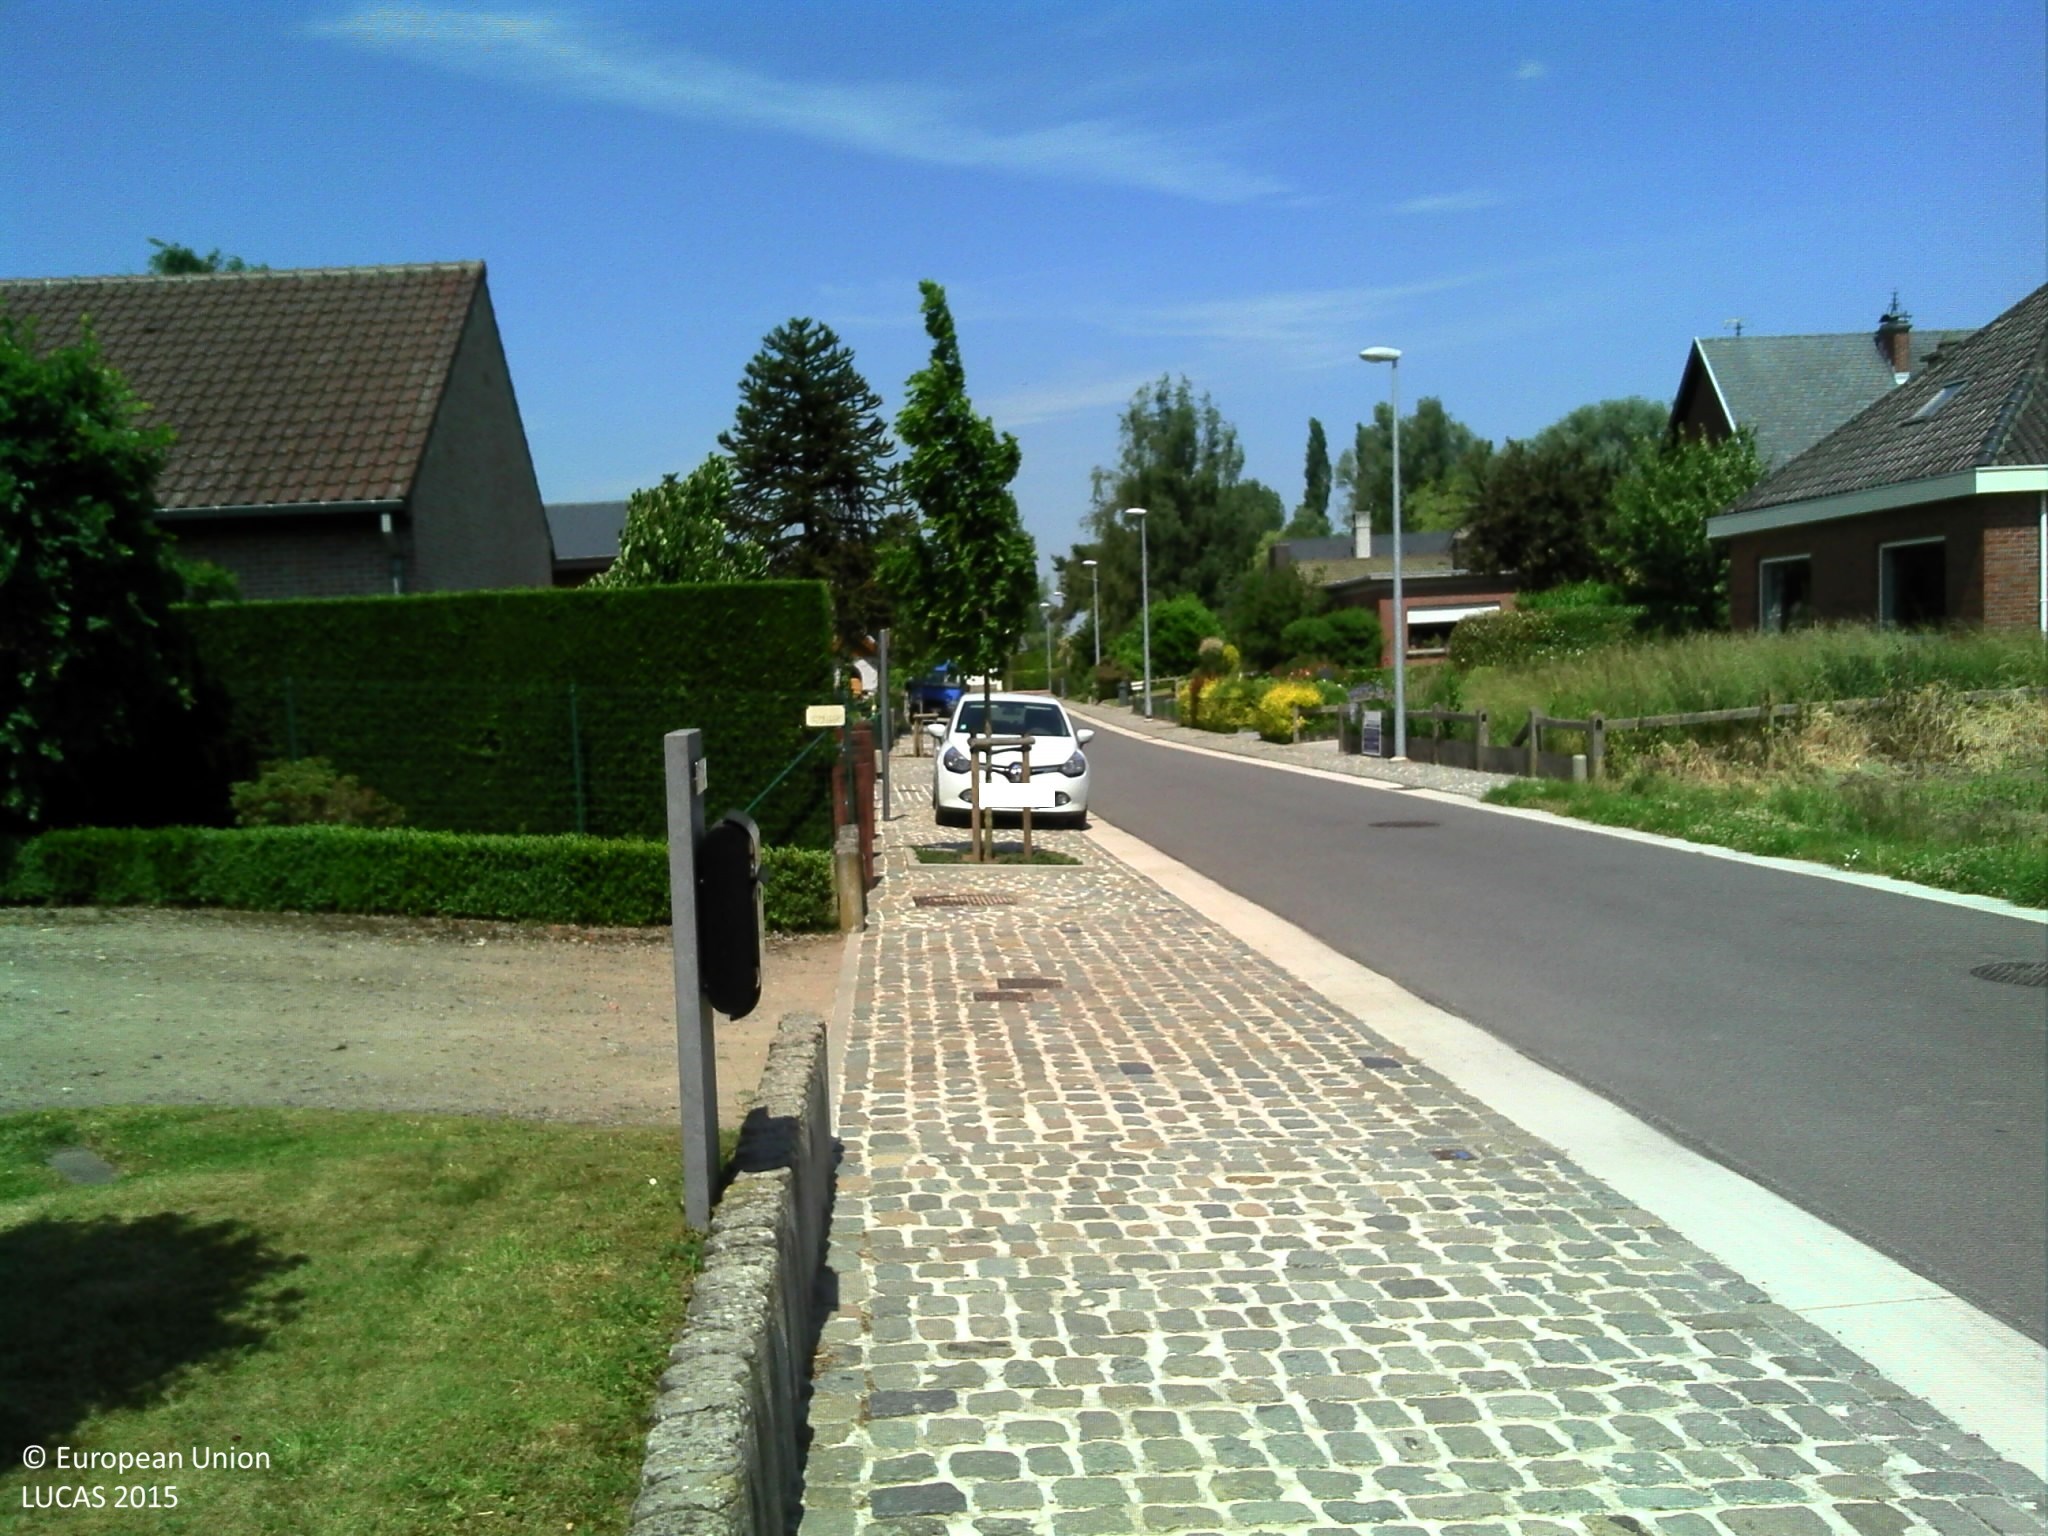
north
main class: Grassland
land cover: Grassland with sparse tree/shrub cover
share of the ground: > 75 %
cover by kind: herbaceous plants 95 %, broadleaved forest trees 5 %
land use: Residential
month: June
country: BE
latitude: 51.0592
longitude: 4.1018
